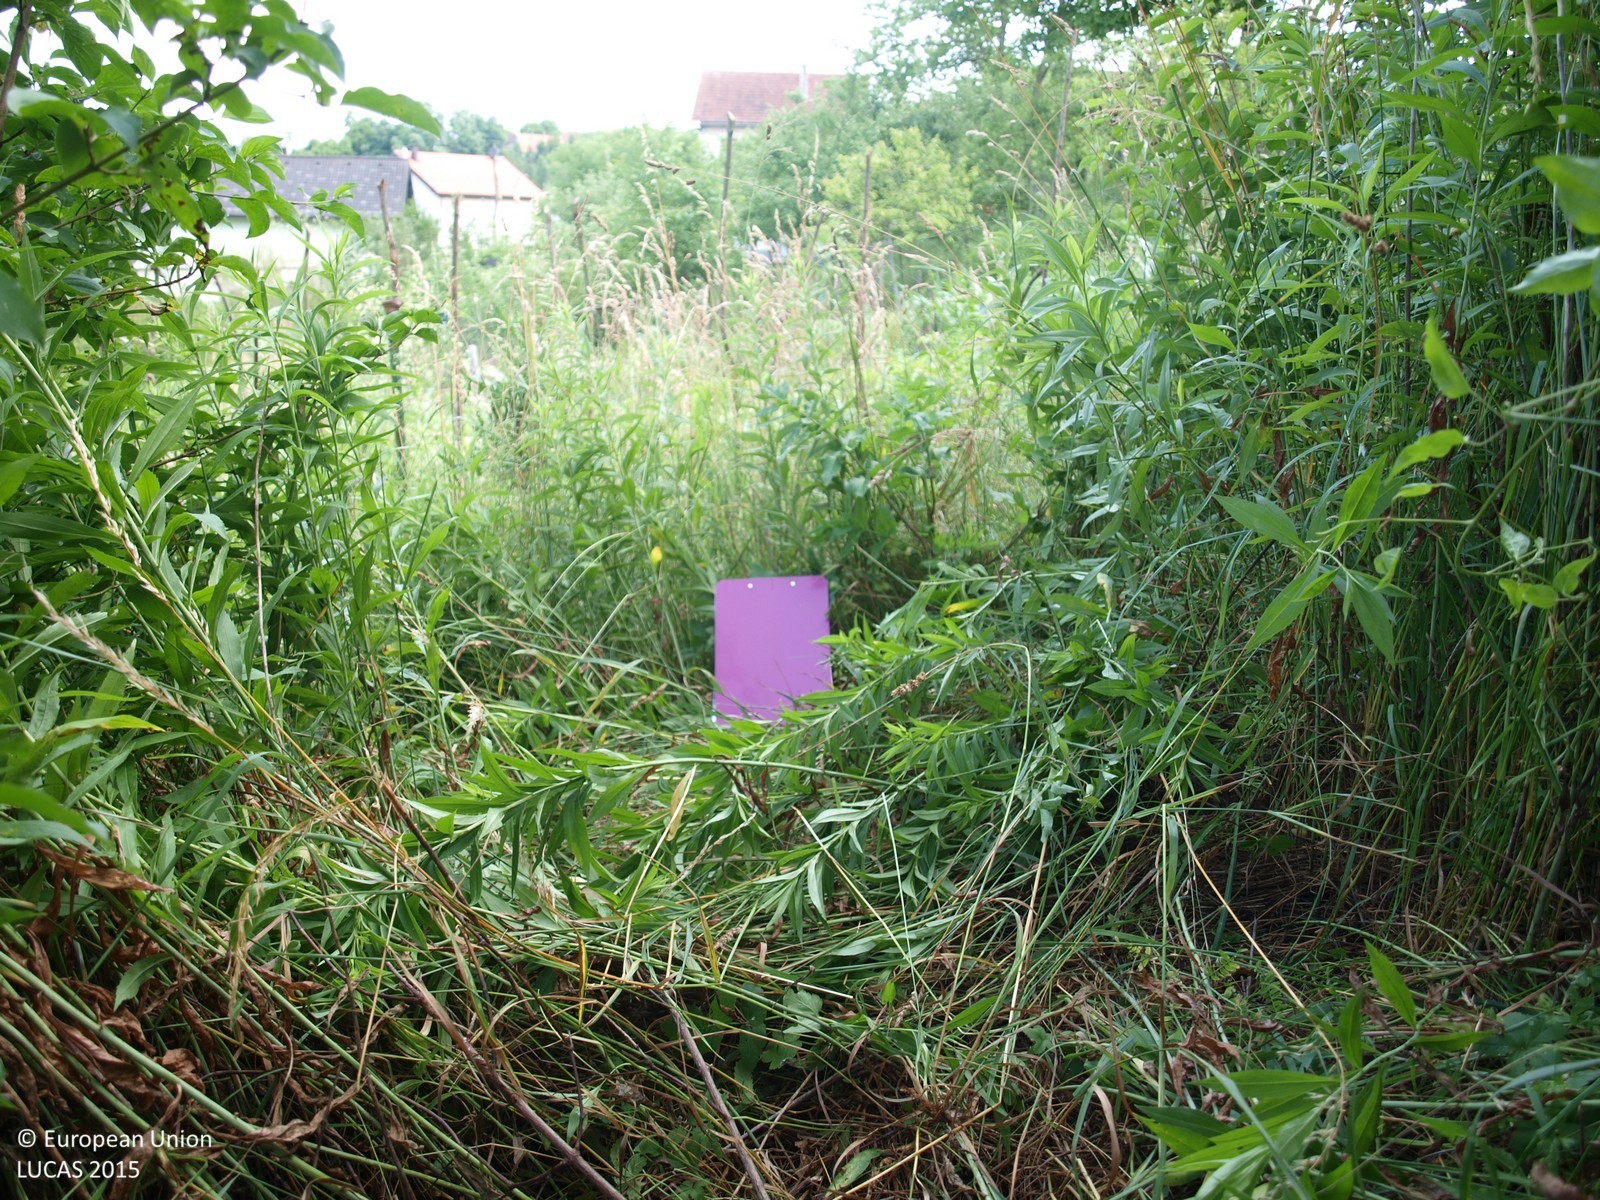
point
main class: Shrubland
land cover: Shrubland with sparse tree cover
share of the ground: > 75 %
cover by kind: shrubs 85 %, herbaceous plants 10 %, broadleaved forest trees 5 %
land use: Abandoned areas
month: June
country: HR
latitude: 46.1815
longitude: 16.3347
